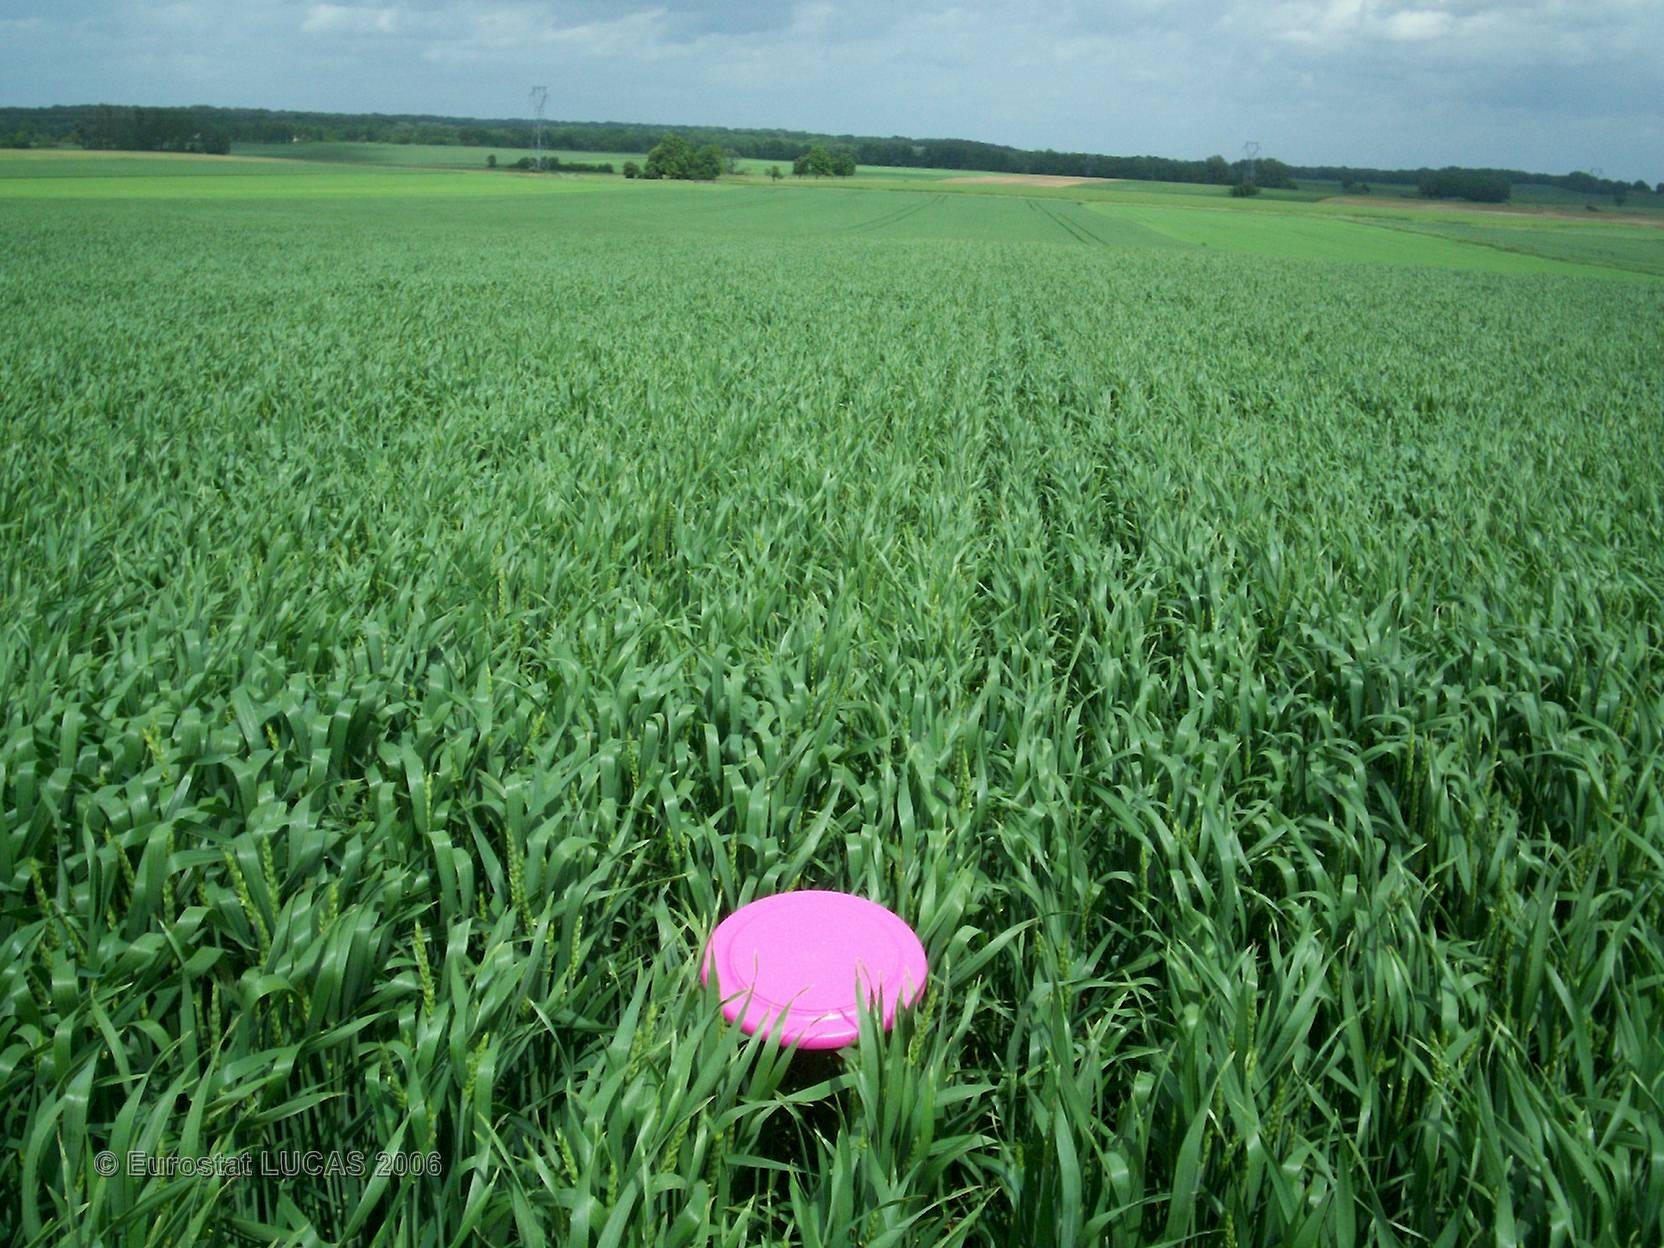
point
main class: Cropland
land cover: Common wheat
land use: Agriculture (excluding fallow land and kitchen gardens)
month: May
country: FR
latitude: 48.3557
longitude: 4.4777
